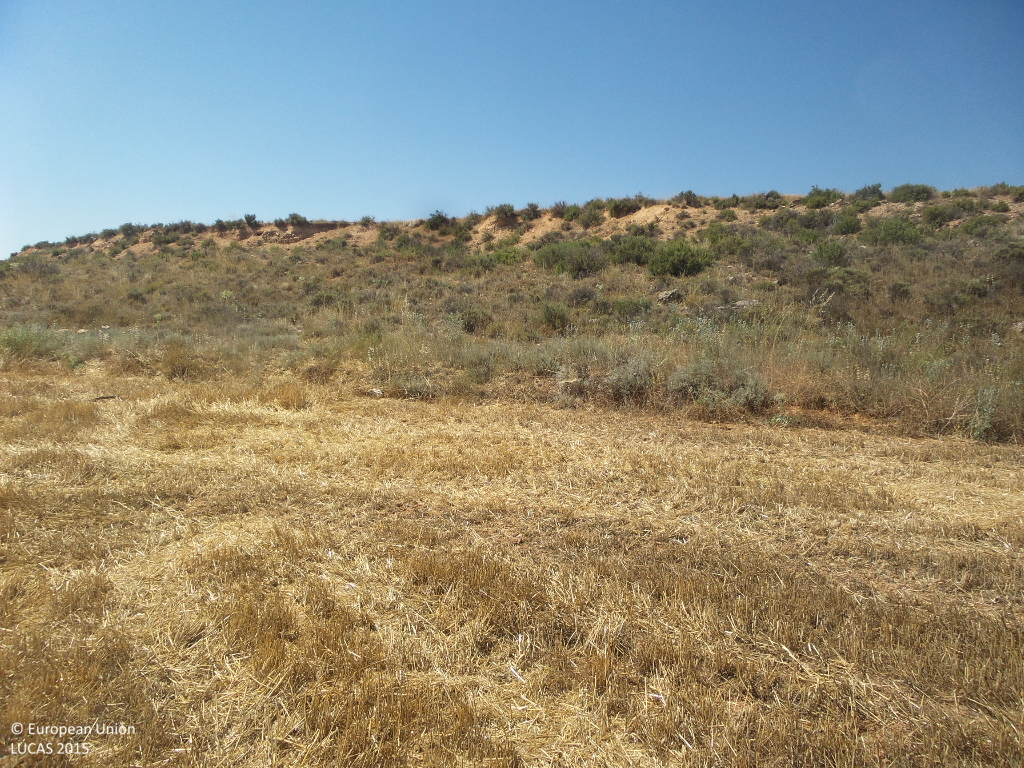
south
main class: Cropland
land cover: Common wheat
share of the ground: < 10 %
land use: Agriculture (excluding fallow land and kitchen gardens)
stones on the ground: < 10 %
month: July
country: ES
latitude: 41.3198
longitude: -2.1314
